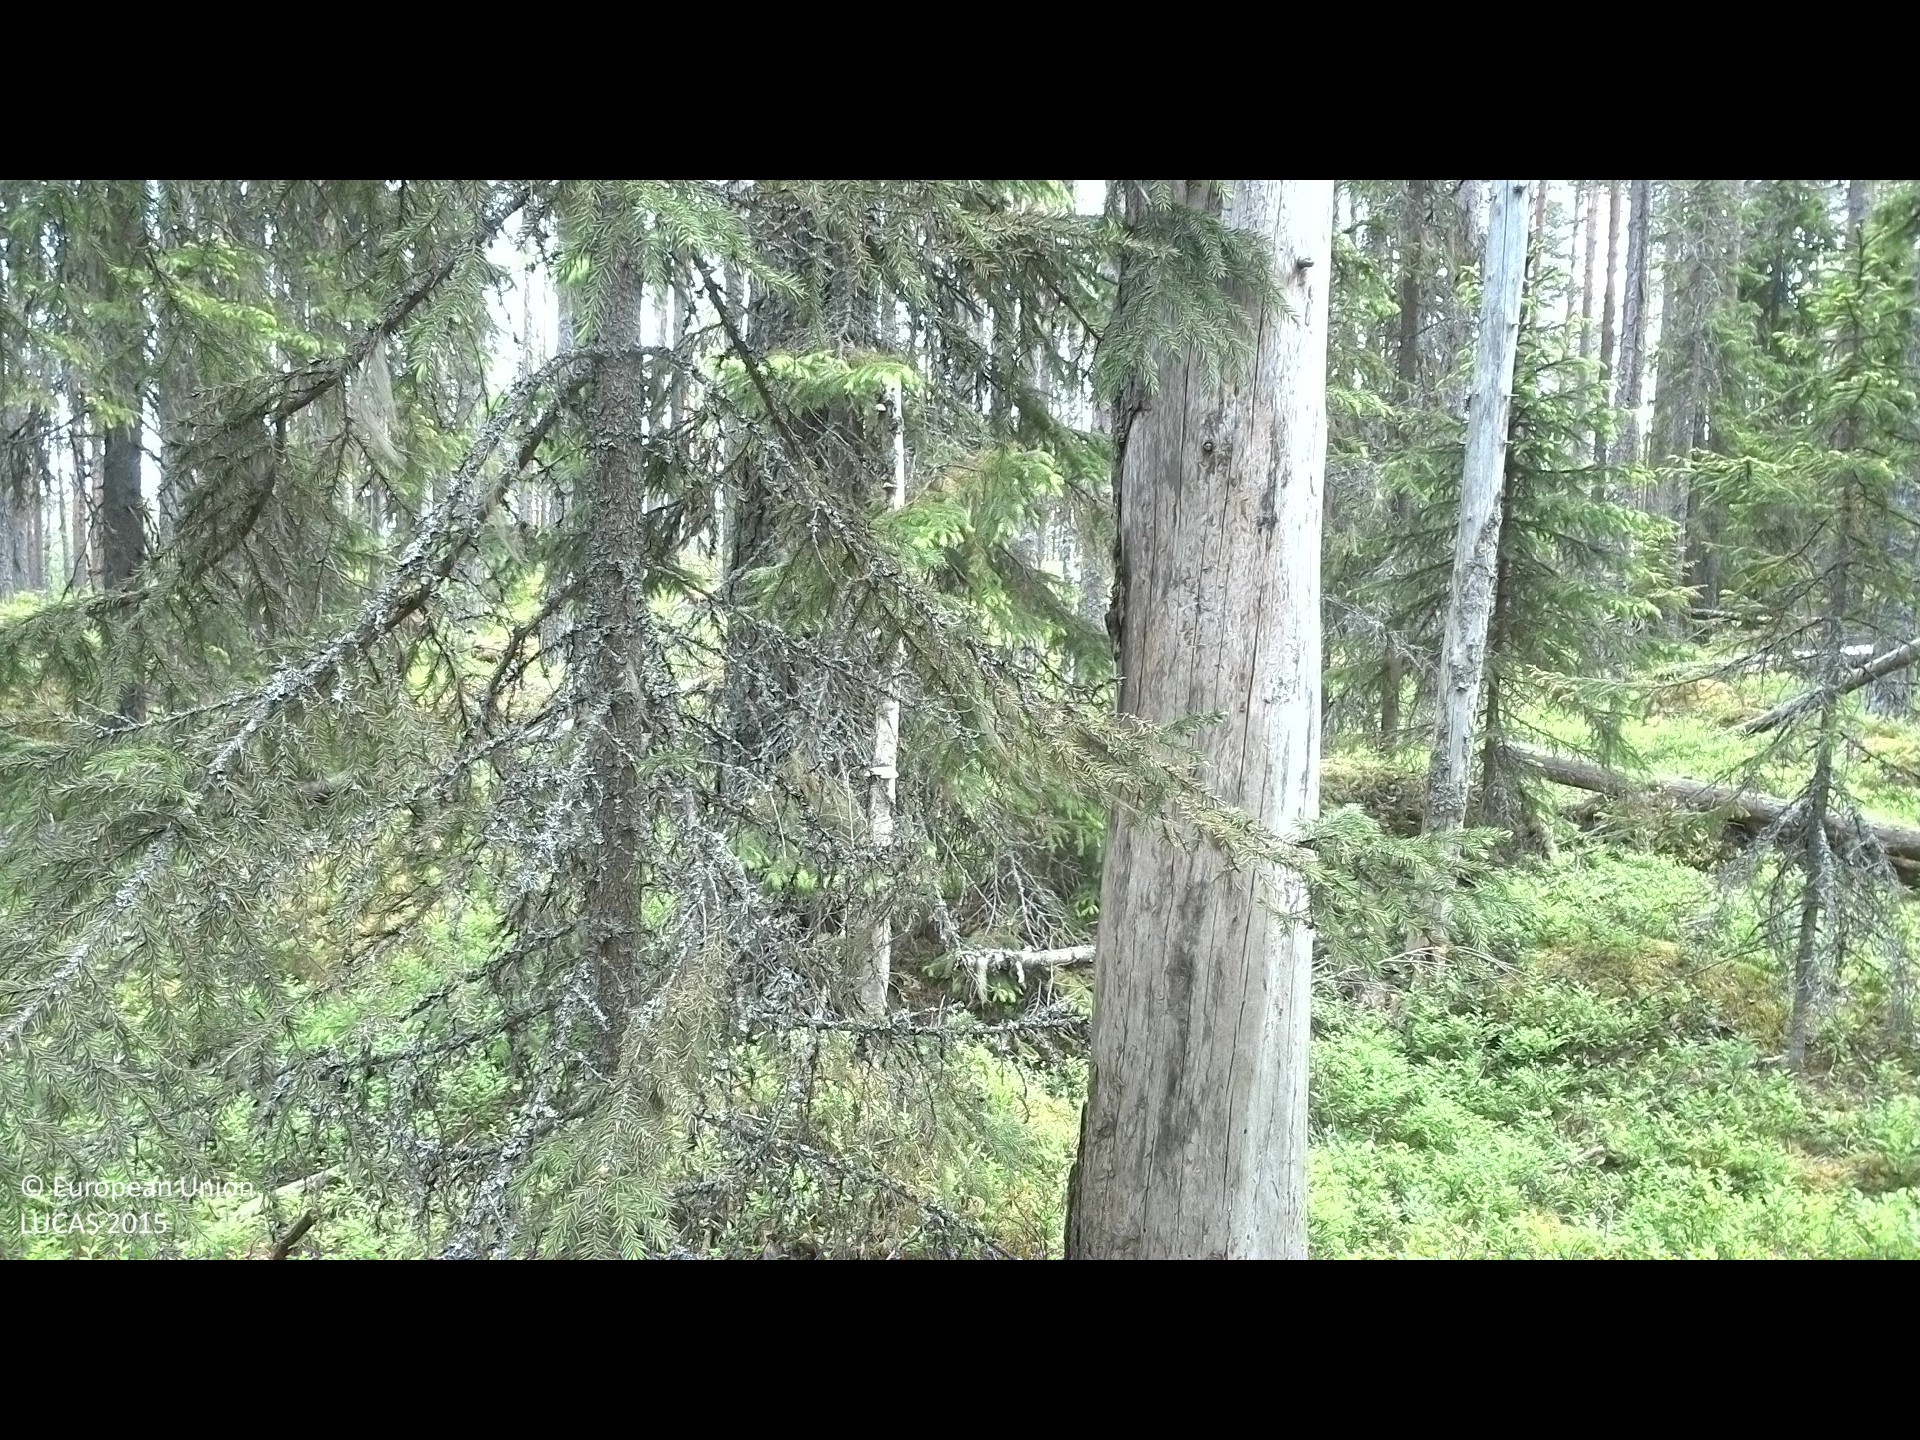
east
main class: Woodland
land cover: Pine dominated coniferous woodland
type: boreal forest
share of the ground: 25 - 50 %
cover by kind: coniferous forest trees 45 %, lichens and mosses 25 %, shrubs 20 %, broadleaved forest trees 10 %
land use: Forestry
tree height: > 5 m
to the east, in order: Pine dominated coniferous woodland; Shrubland with sparse tree cover; Broadleaved woodland
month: June
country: SE
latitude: 61.9610
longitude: 16.1794
